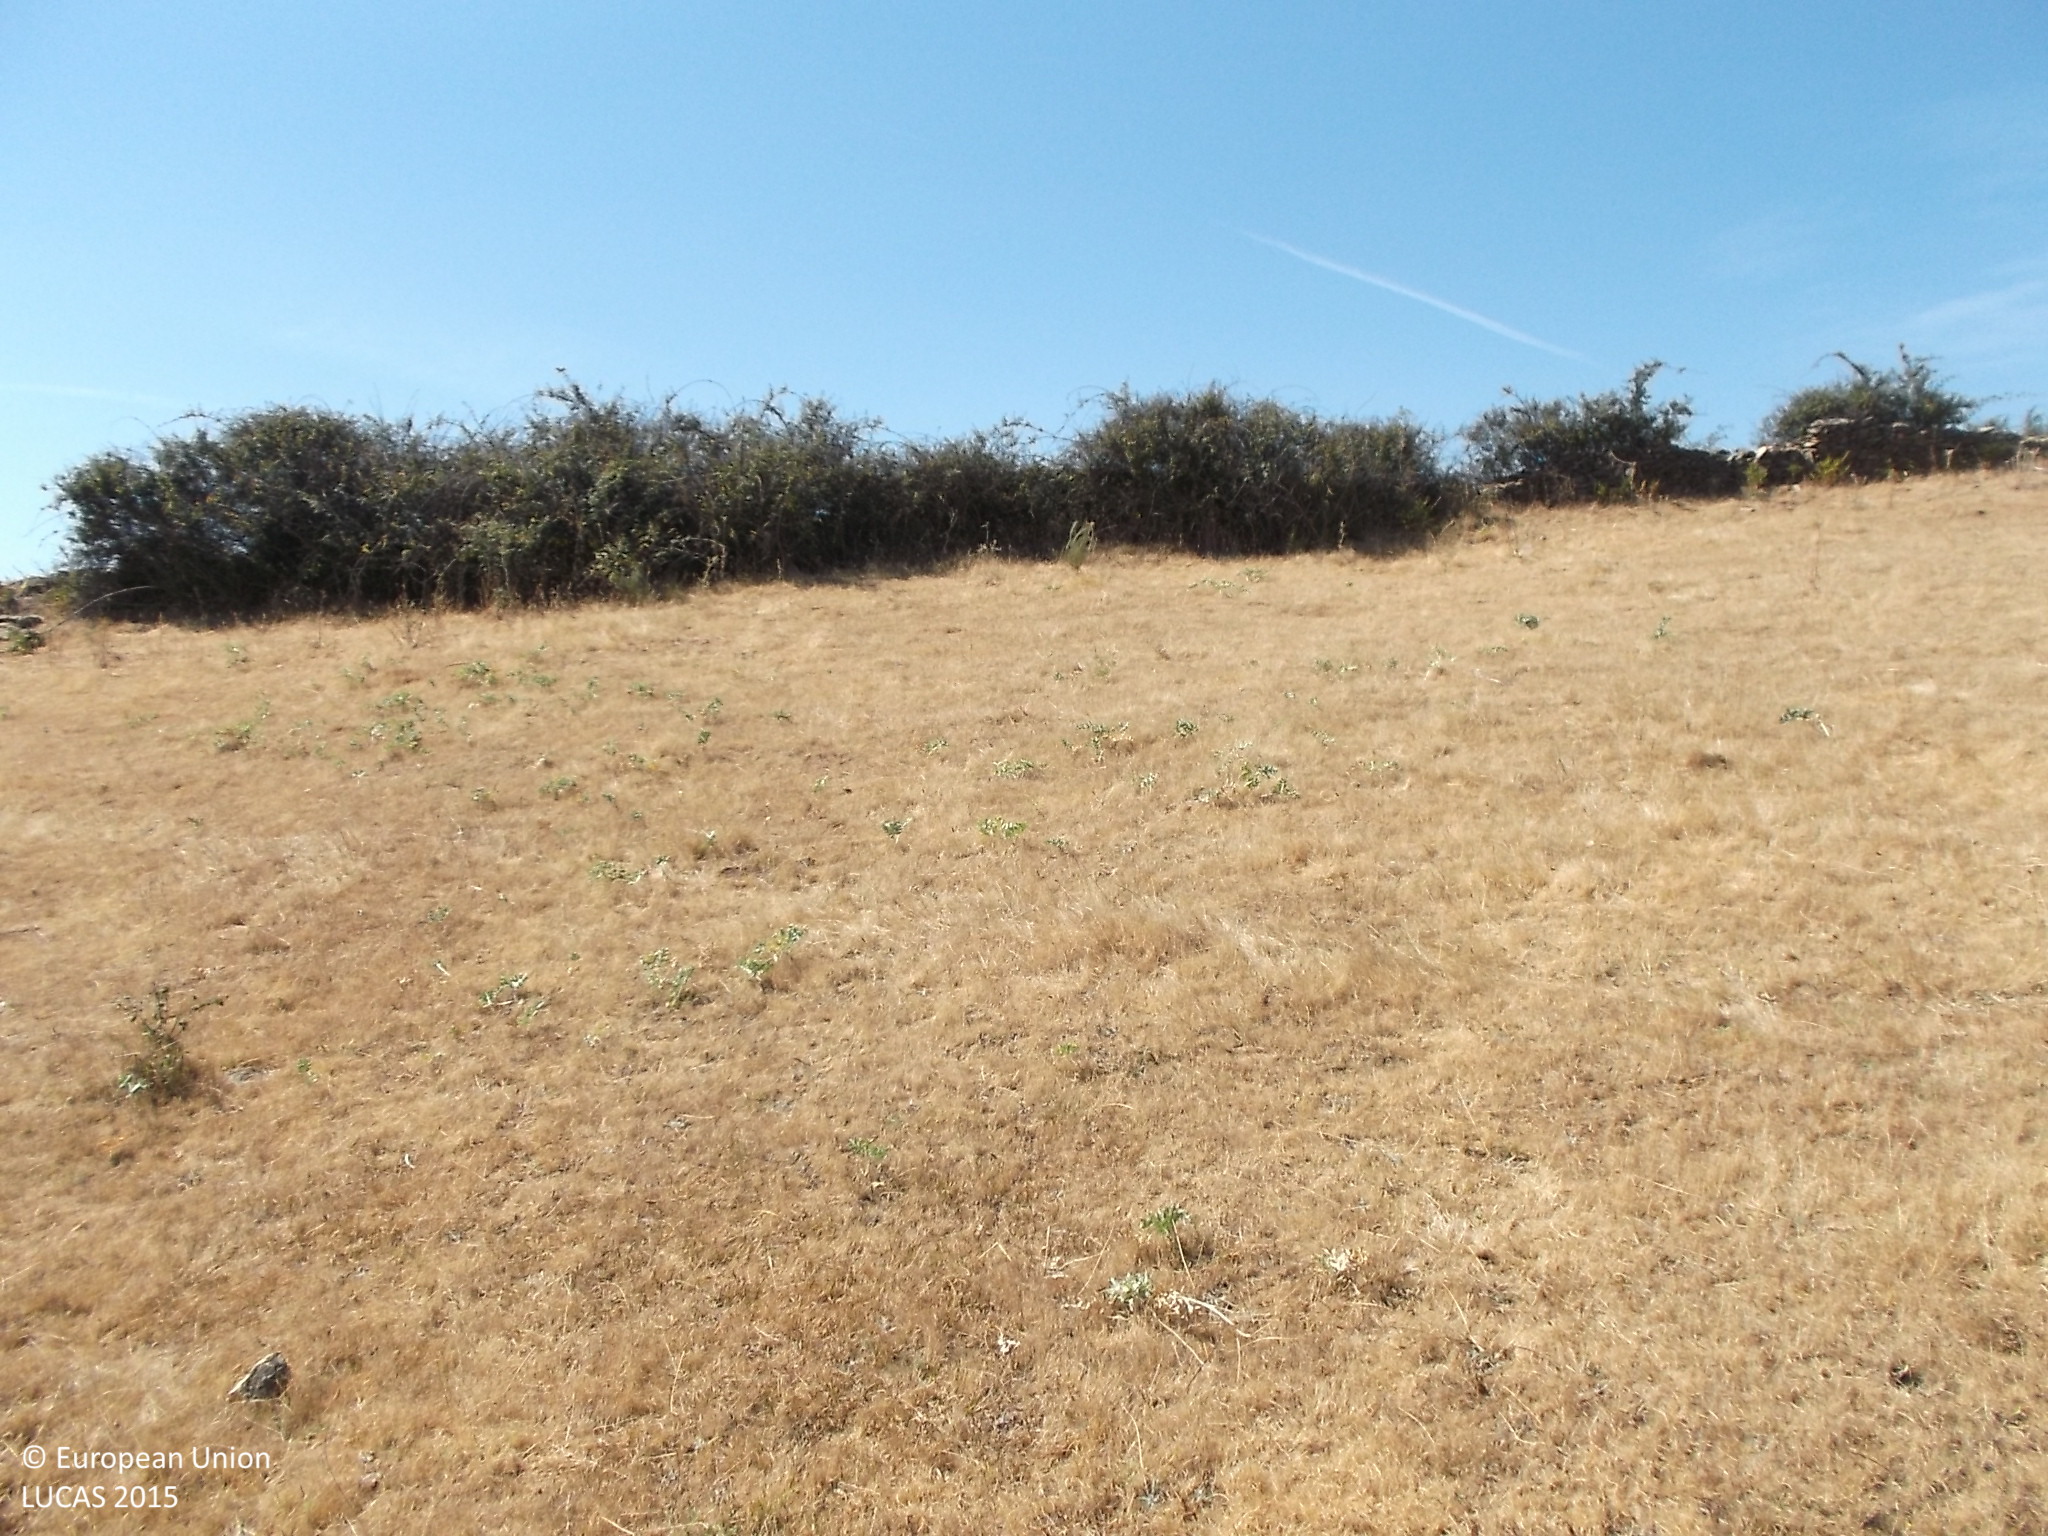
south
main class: Grassland
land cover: Grassland without tree/shrub cover
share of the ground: > 75 %
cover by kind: herbaceous plants 100 %
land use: Agriculture (excluding fallow land and kitchen gardens)
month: July
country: ES
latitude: 40.6860
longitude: -6.6958
